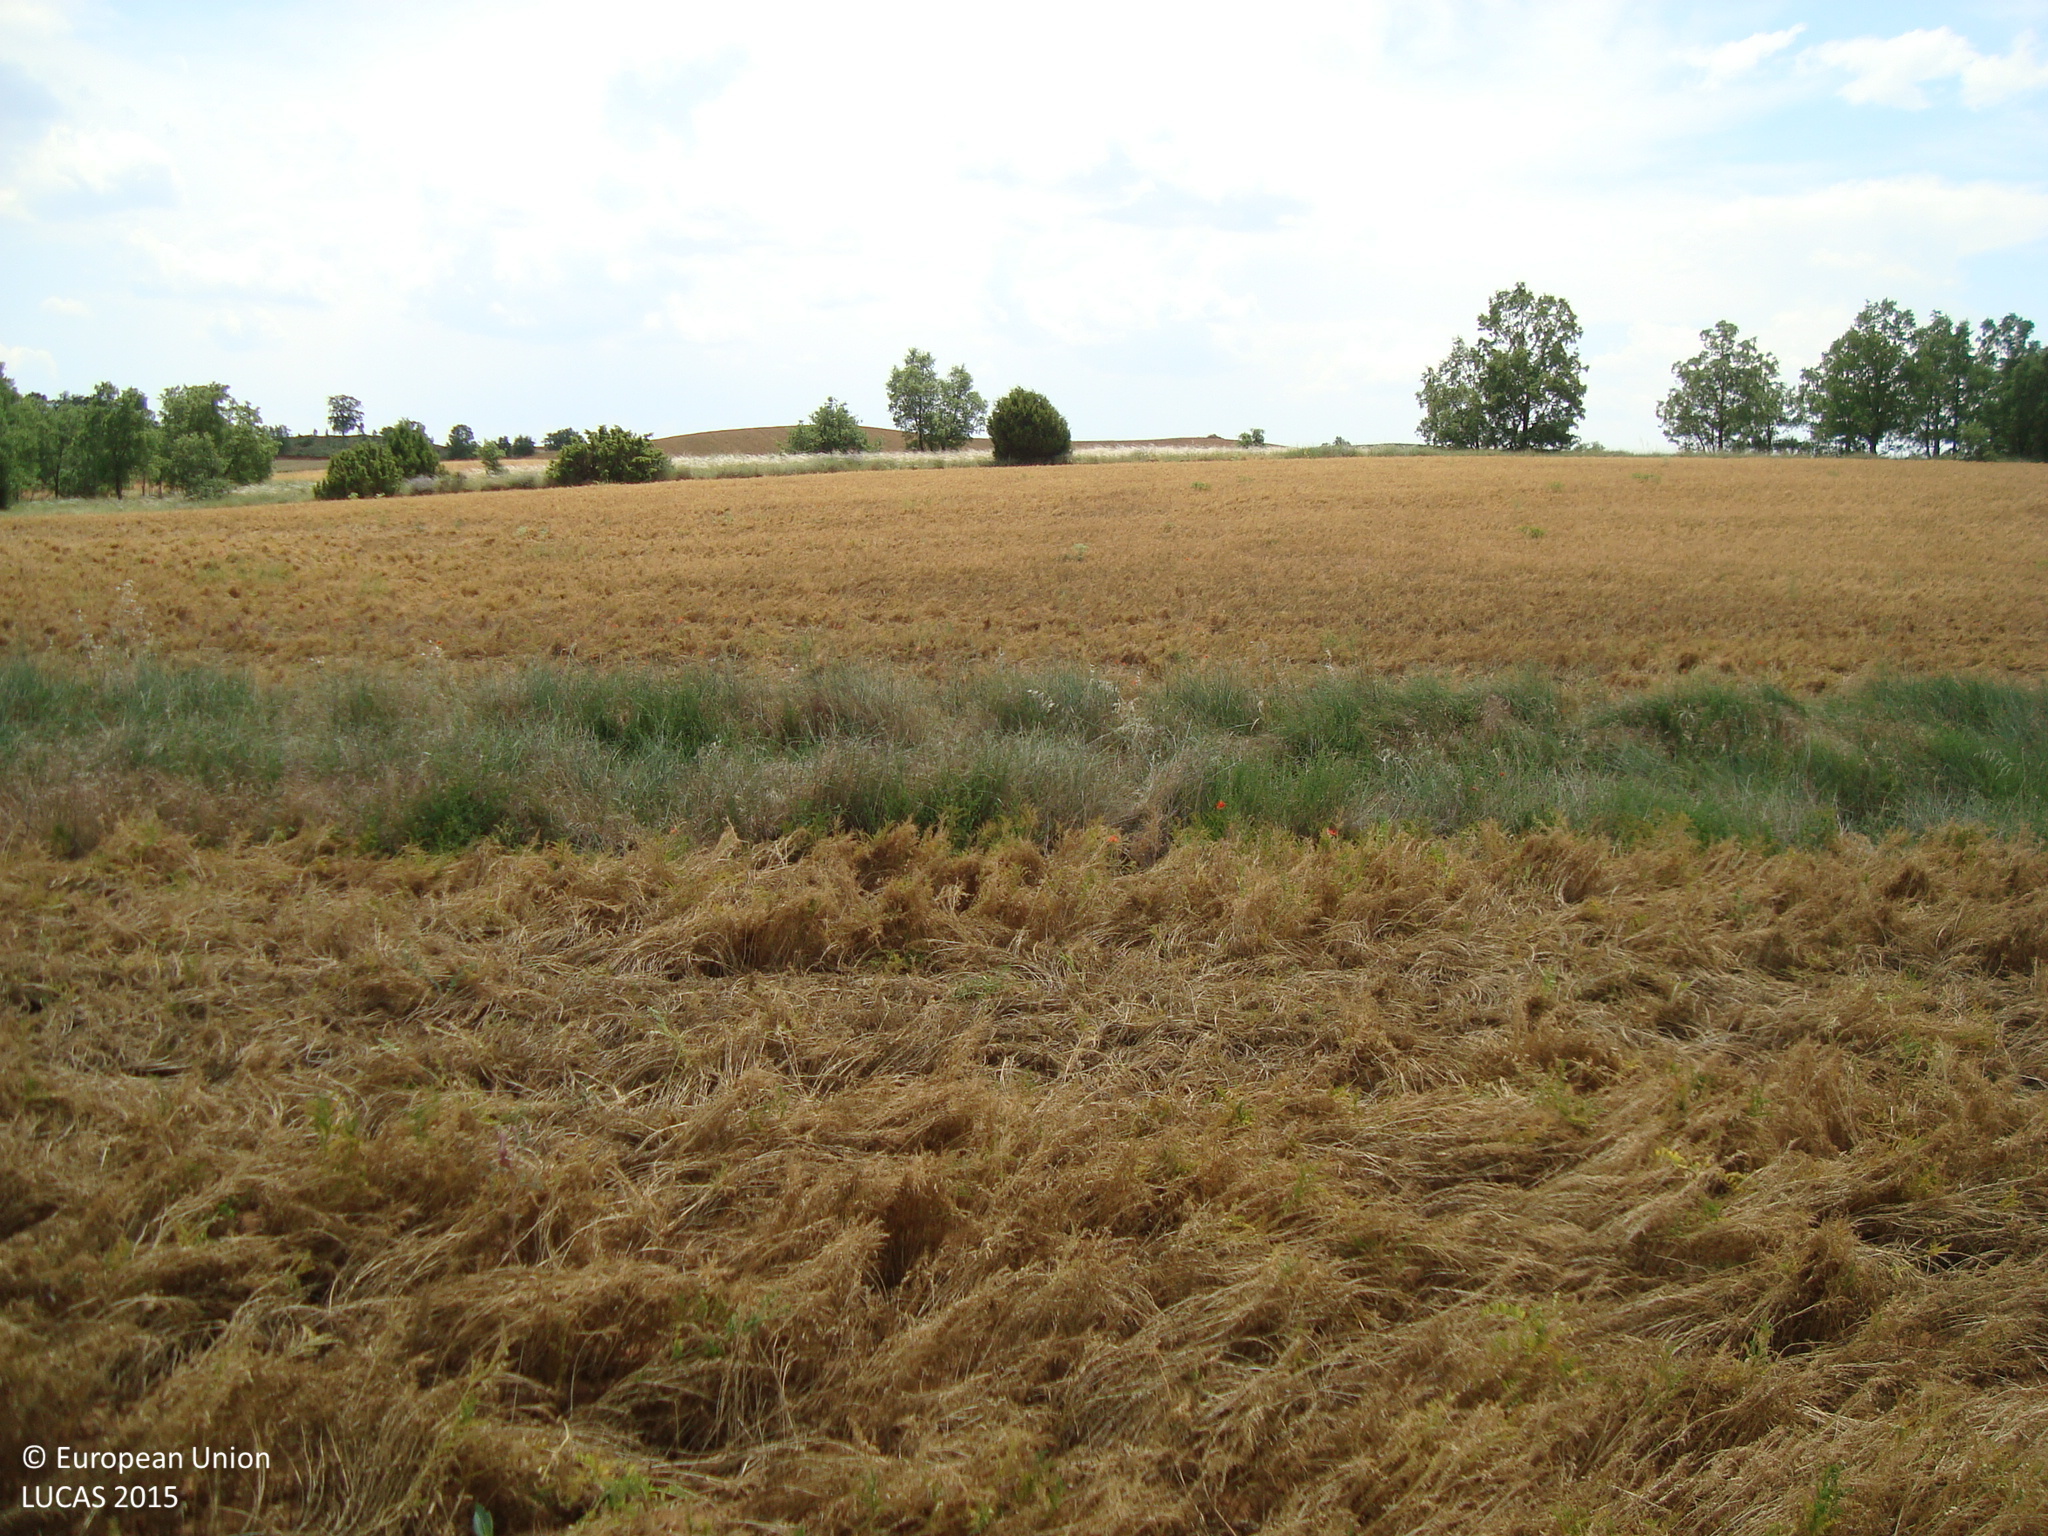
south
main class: Cropland
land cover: Dry pulses
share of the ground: > 75 %
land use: Agriculture (excluding fallow land and kitchen gardens)
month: June
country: ES
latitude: 41.8834
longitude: -3.5623
